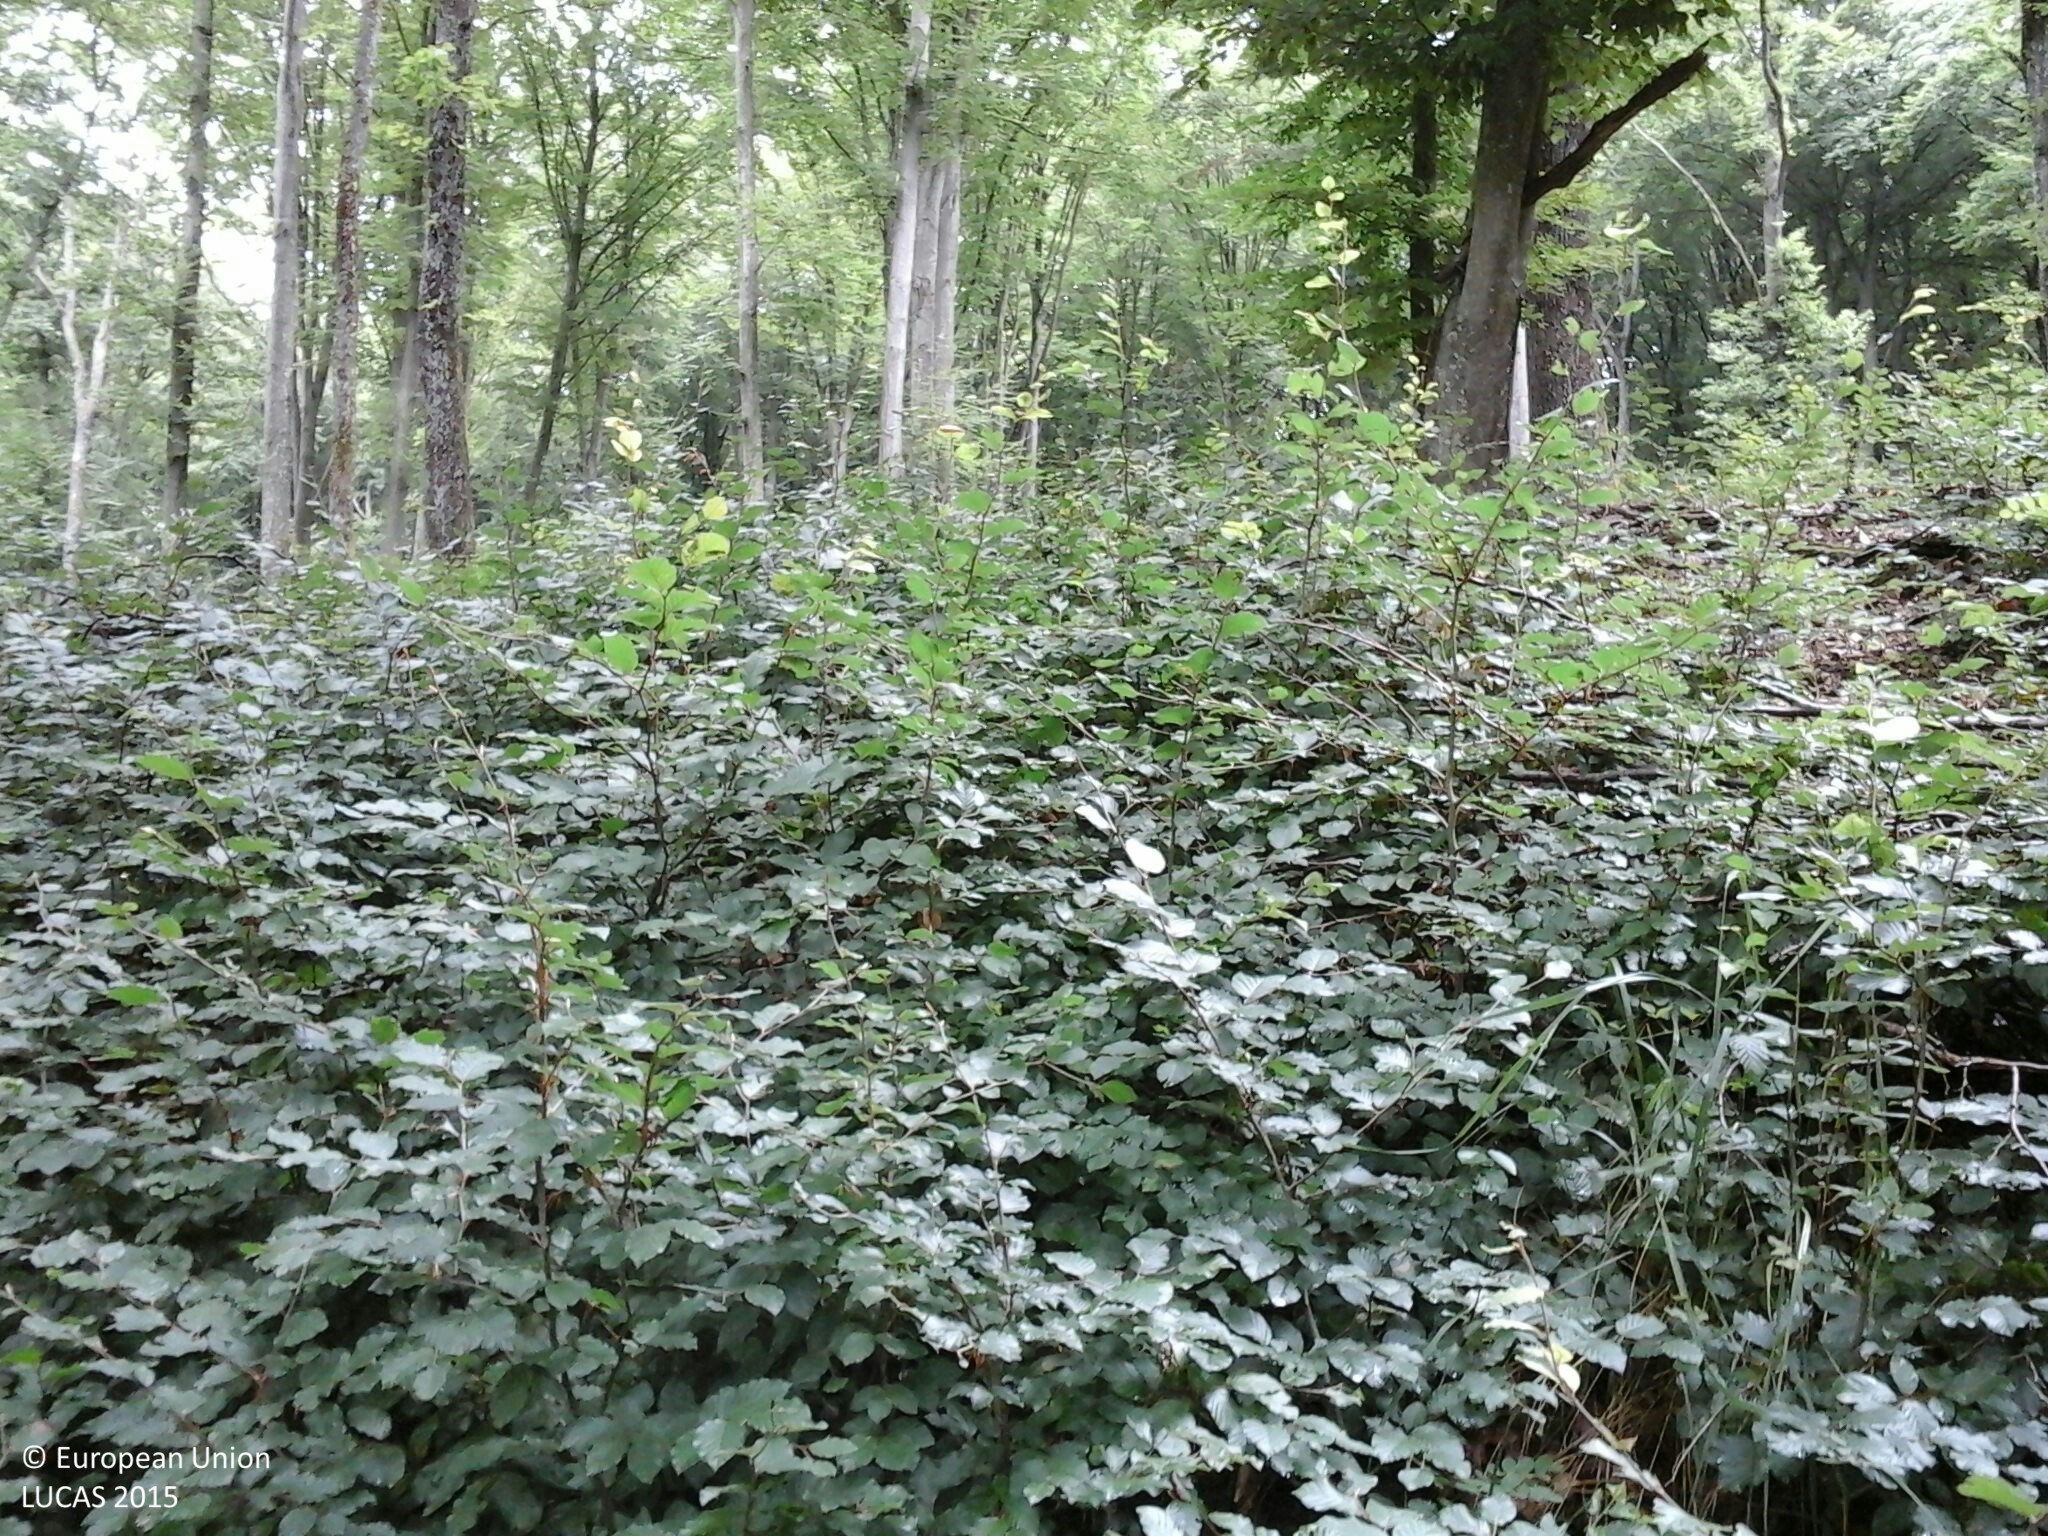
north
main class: Woodland
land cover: Broadleaved woodland
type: beech forest
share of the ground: > 75 %
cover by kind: broadleaved forest trees 85 %, shrubs 10 %, herbaceous plants 5 %
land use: Forestry
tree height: > 5 m
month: July
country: HU
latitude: 46.7733
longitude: 16.4055
